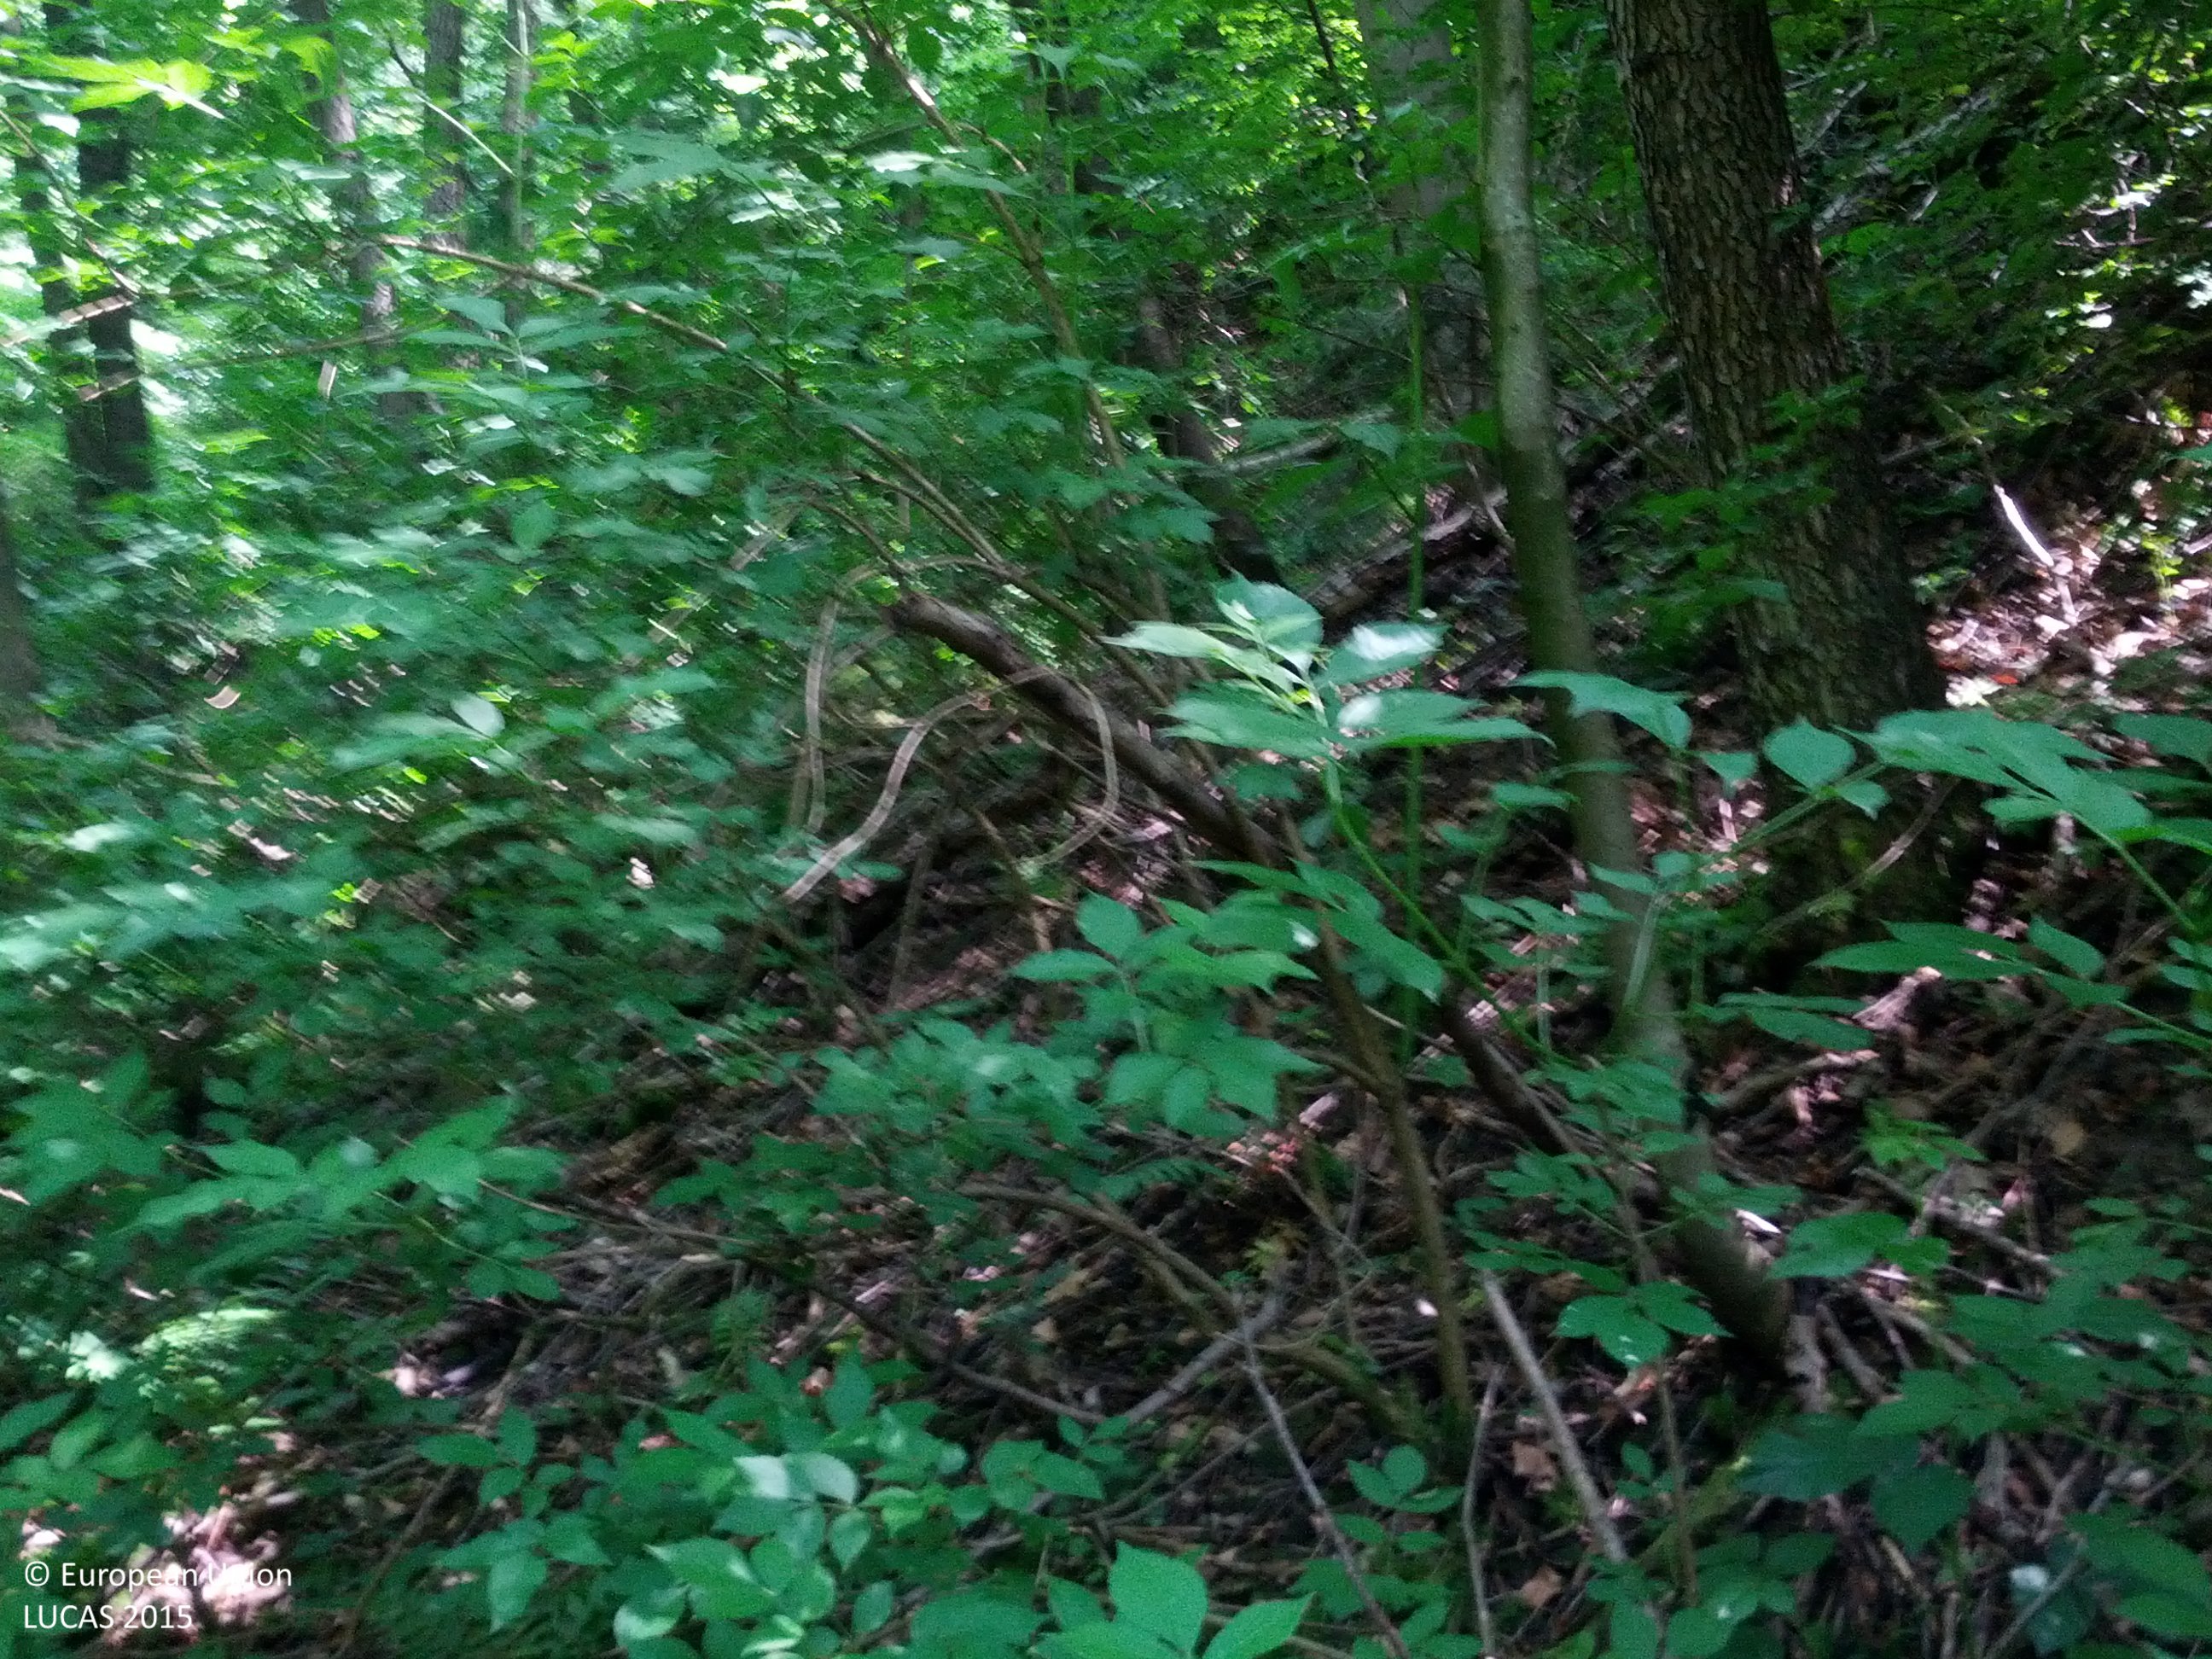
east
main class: Woodland
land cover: Broadleaved woodland
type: beech forest
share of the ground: > 75 %
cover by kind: broadleaved forest trees 80 %, shrubs 10 %, herbaceous plants 10 %
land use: Forestry
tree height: > 5 m
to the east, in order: Broadleaved woodland; Rivers and streams; Broadleaved woodland; Spruce dominated coniferous woodland; Other bare soil; Spruce dominated coniferous woodland
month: May
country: AT
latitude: 48.2334
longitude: 16.1300
